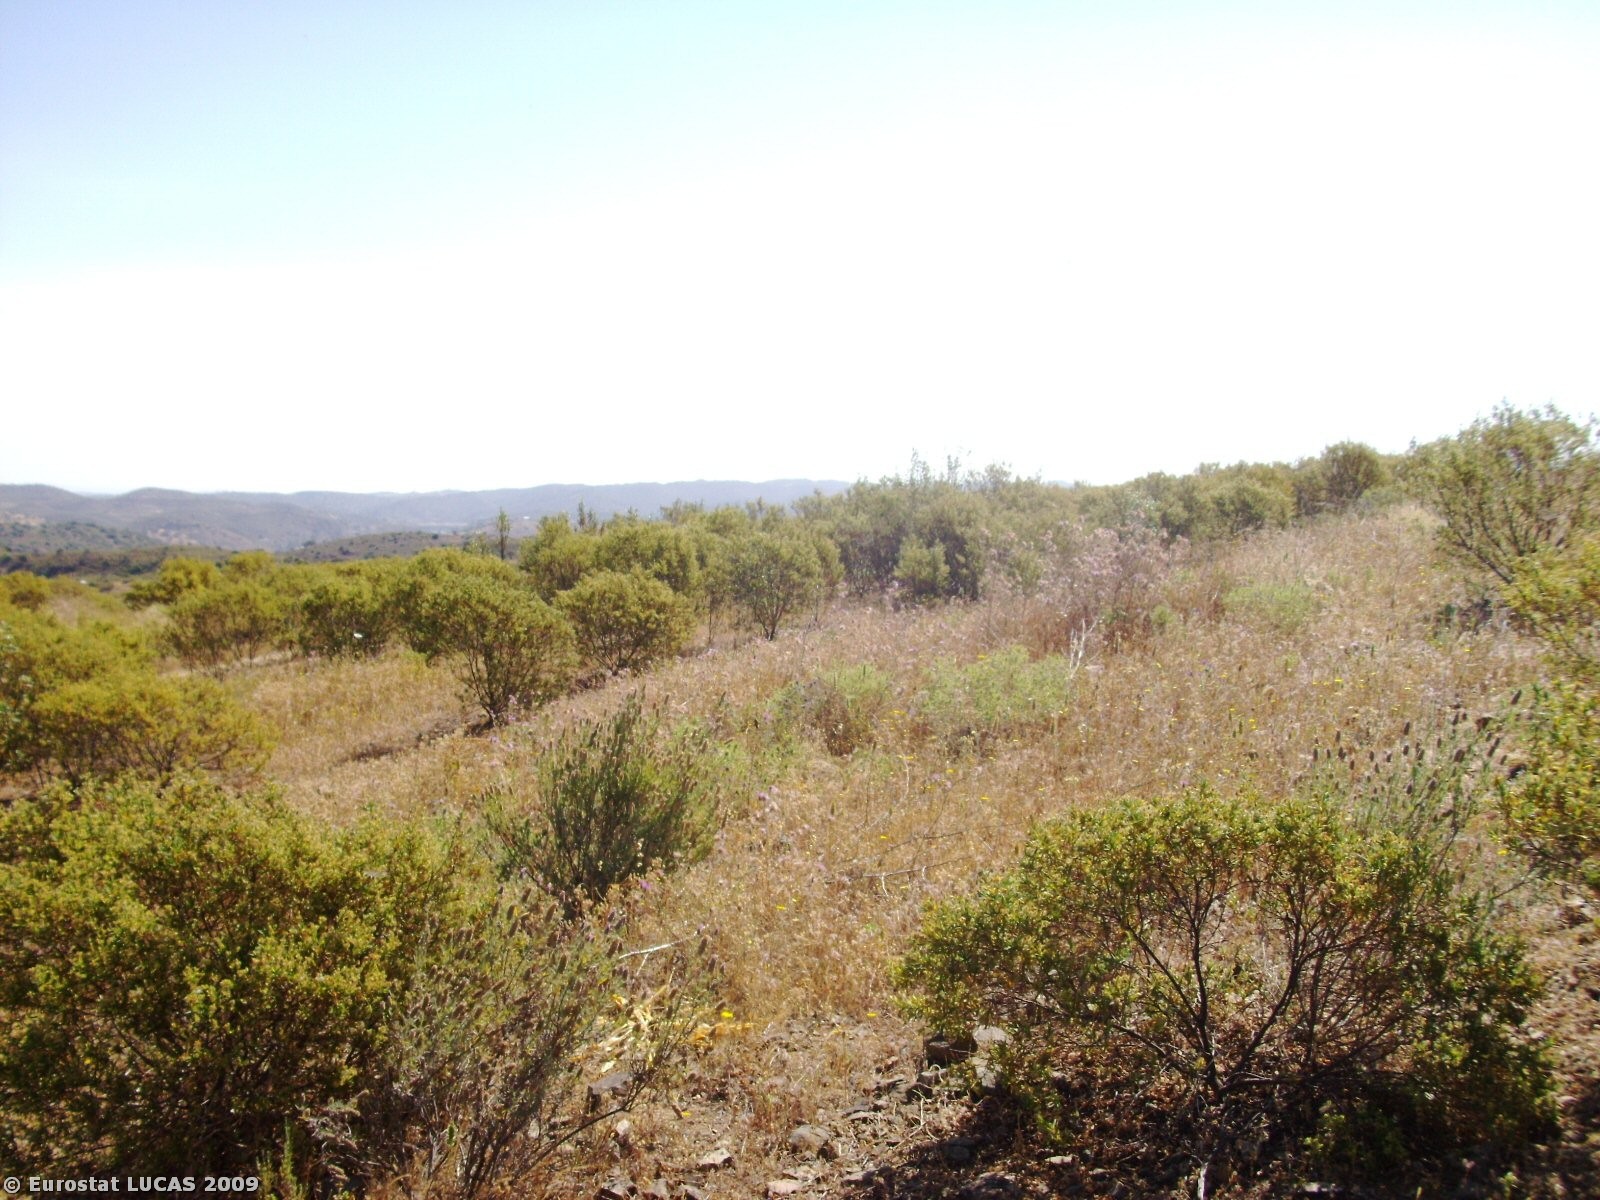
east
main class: Shrubland
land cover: Shrubland without tree cover
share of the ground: 50 - 75 %
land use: Nature reserves
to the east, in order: Shrubland without tree cover; Tracks; Shrubland without tree cover; Tracks; Shrubland without tree cover; Tracks; Shrubland without tree cover
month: May
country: PT
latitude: 37.5414
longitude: -7.5653
